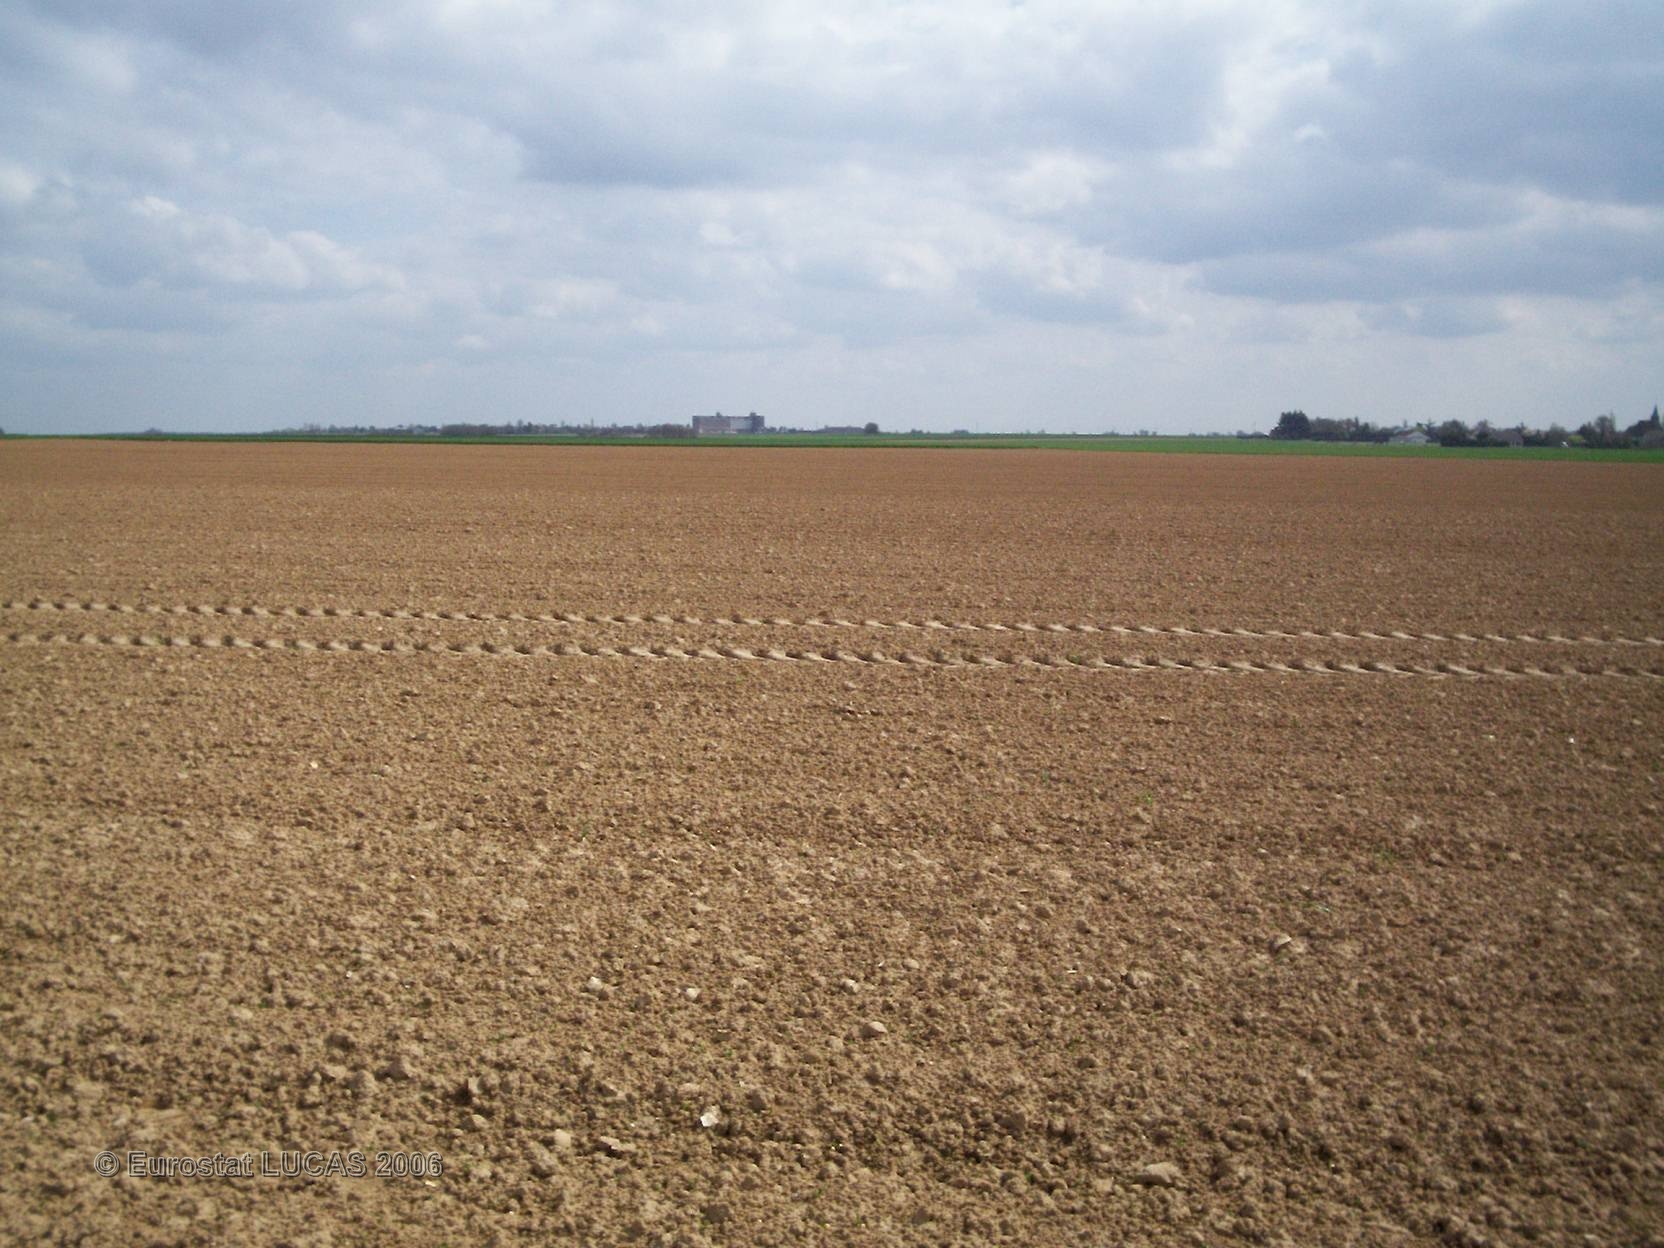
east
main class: Cropland
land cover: Dry pulses
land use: Agriculture (excluding fallow land and kitchen gardens)
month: April
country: FR
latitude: 49.0865
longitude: 1.0097
